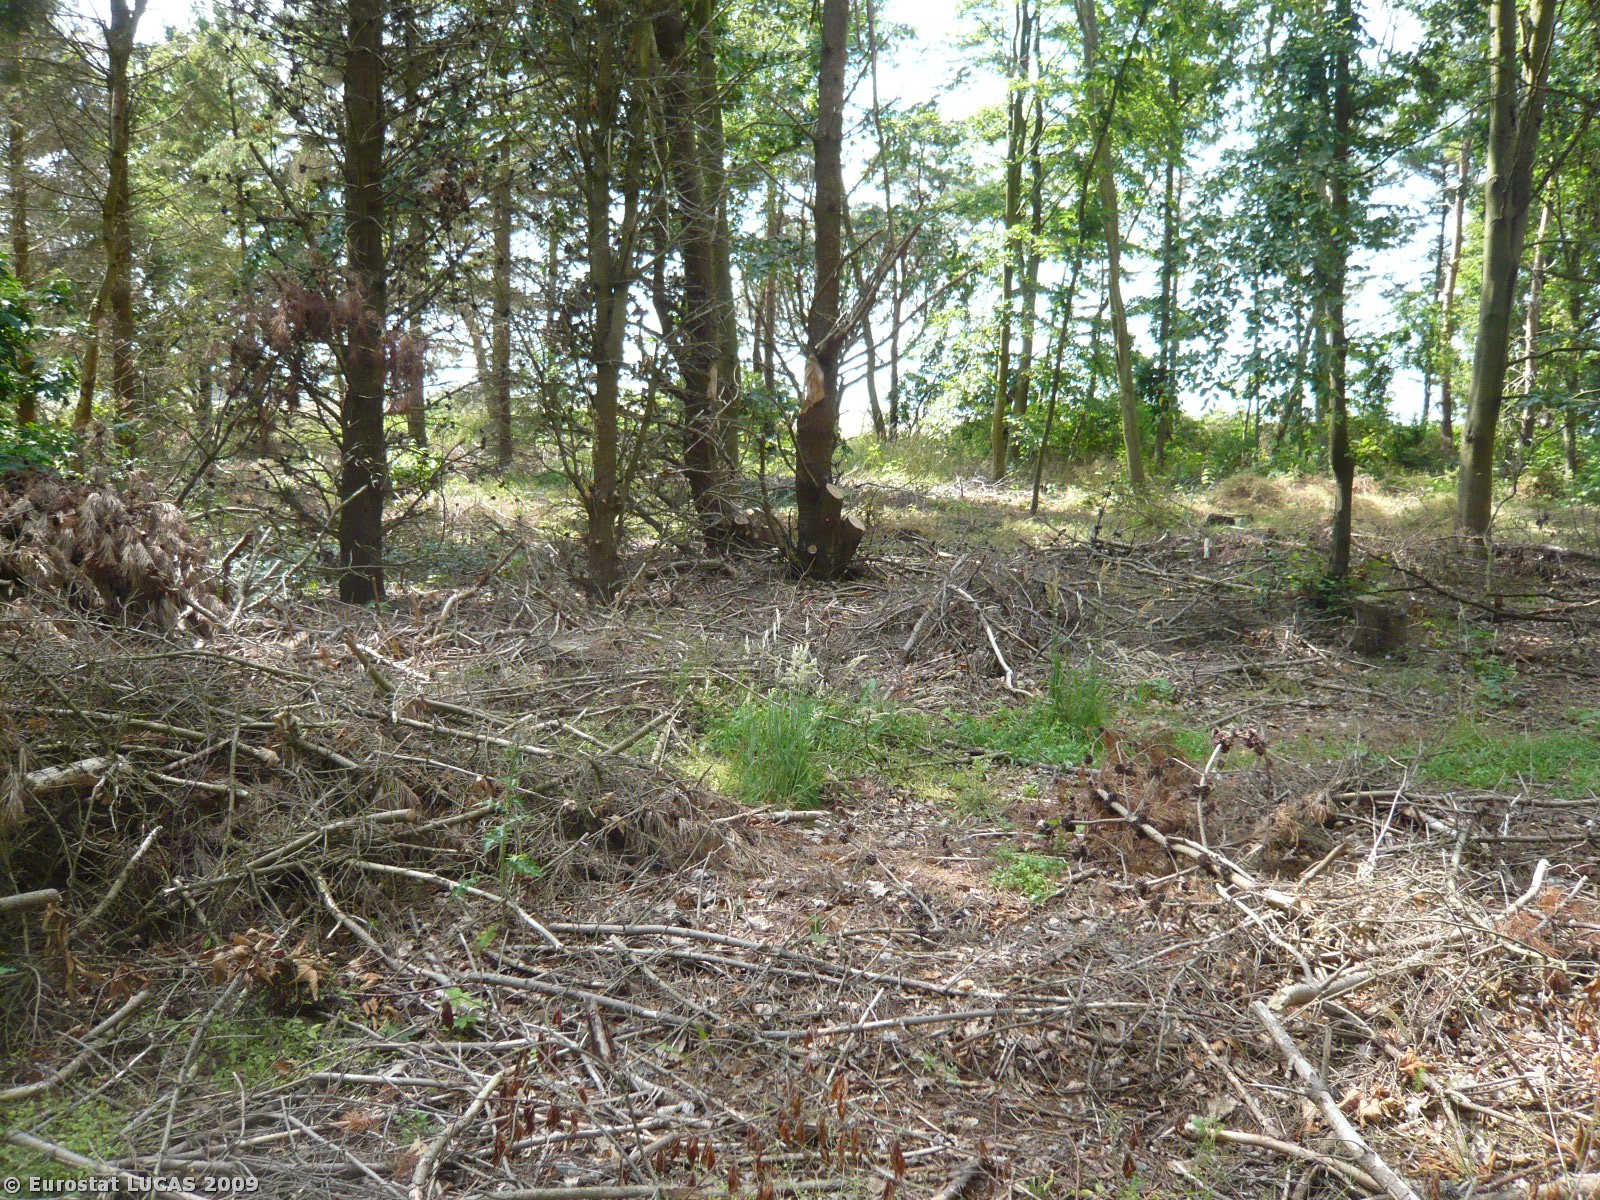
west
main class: Woodland
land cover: Coniferous woodland
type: hemiboreal forest and nemoral coniferous forest and mixed broadleaved-coniferous forest
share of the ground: > 75 %
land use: Forestry
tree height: > 5 m
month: July
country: DK
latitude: 55.9242
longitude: 11.7426
